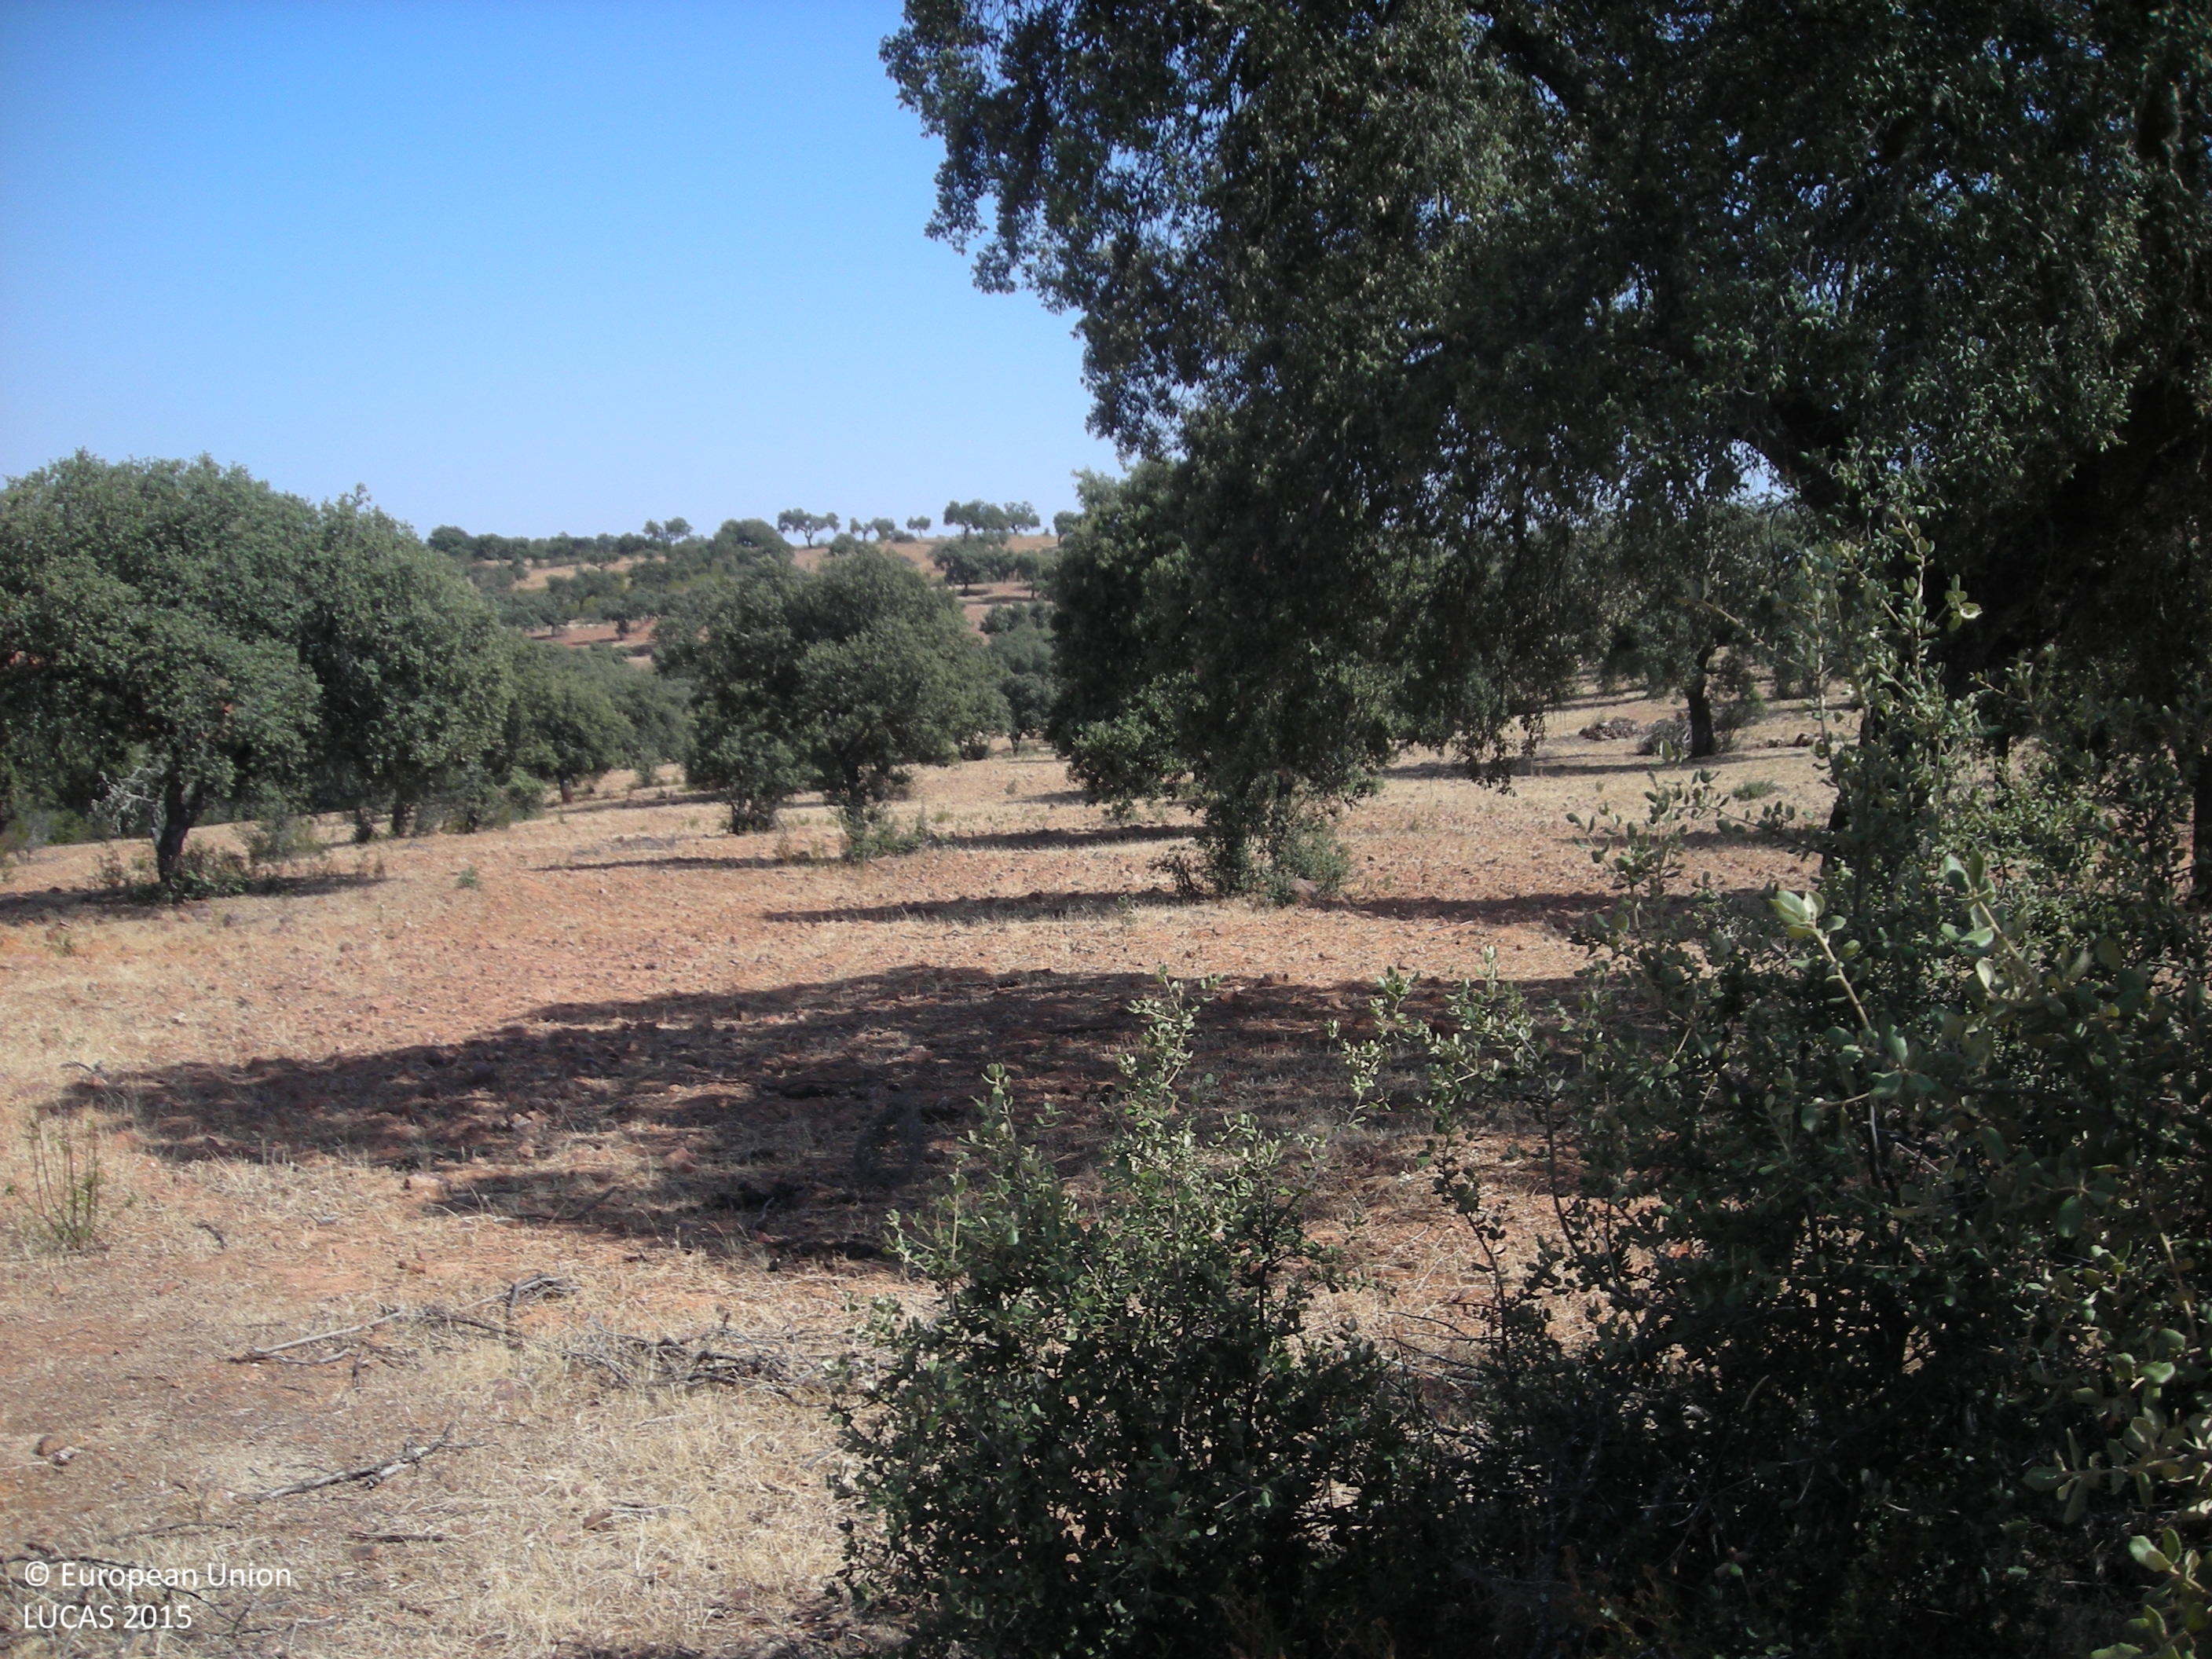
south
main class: Woodland
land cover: Broadleaved woodland
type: broadleaved evergreen forest
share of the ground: 10 - 25 %
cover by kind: unconsolidated bare surface 65 %, herbaceous plants 20 %, broadleaved forest trees 15 %
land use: Forestry
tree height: > 5 m
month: June
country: ES
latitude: 38.6046
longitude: -5.8320
